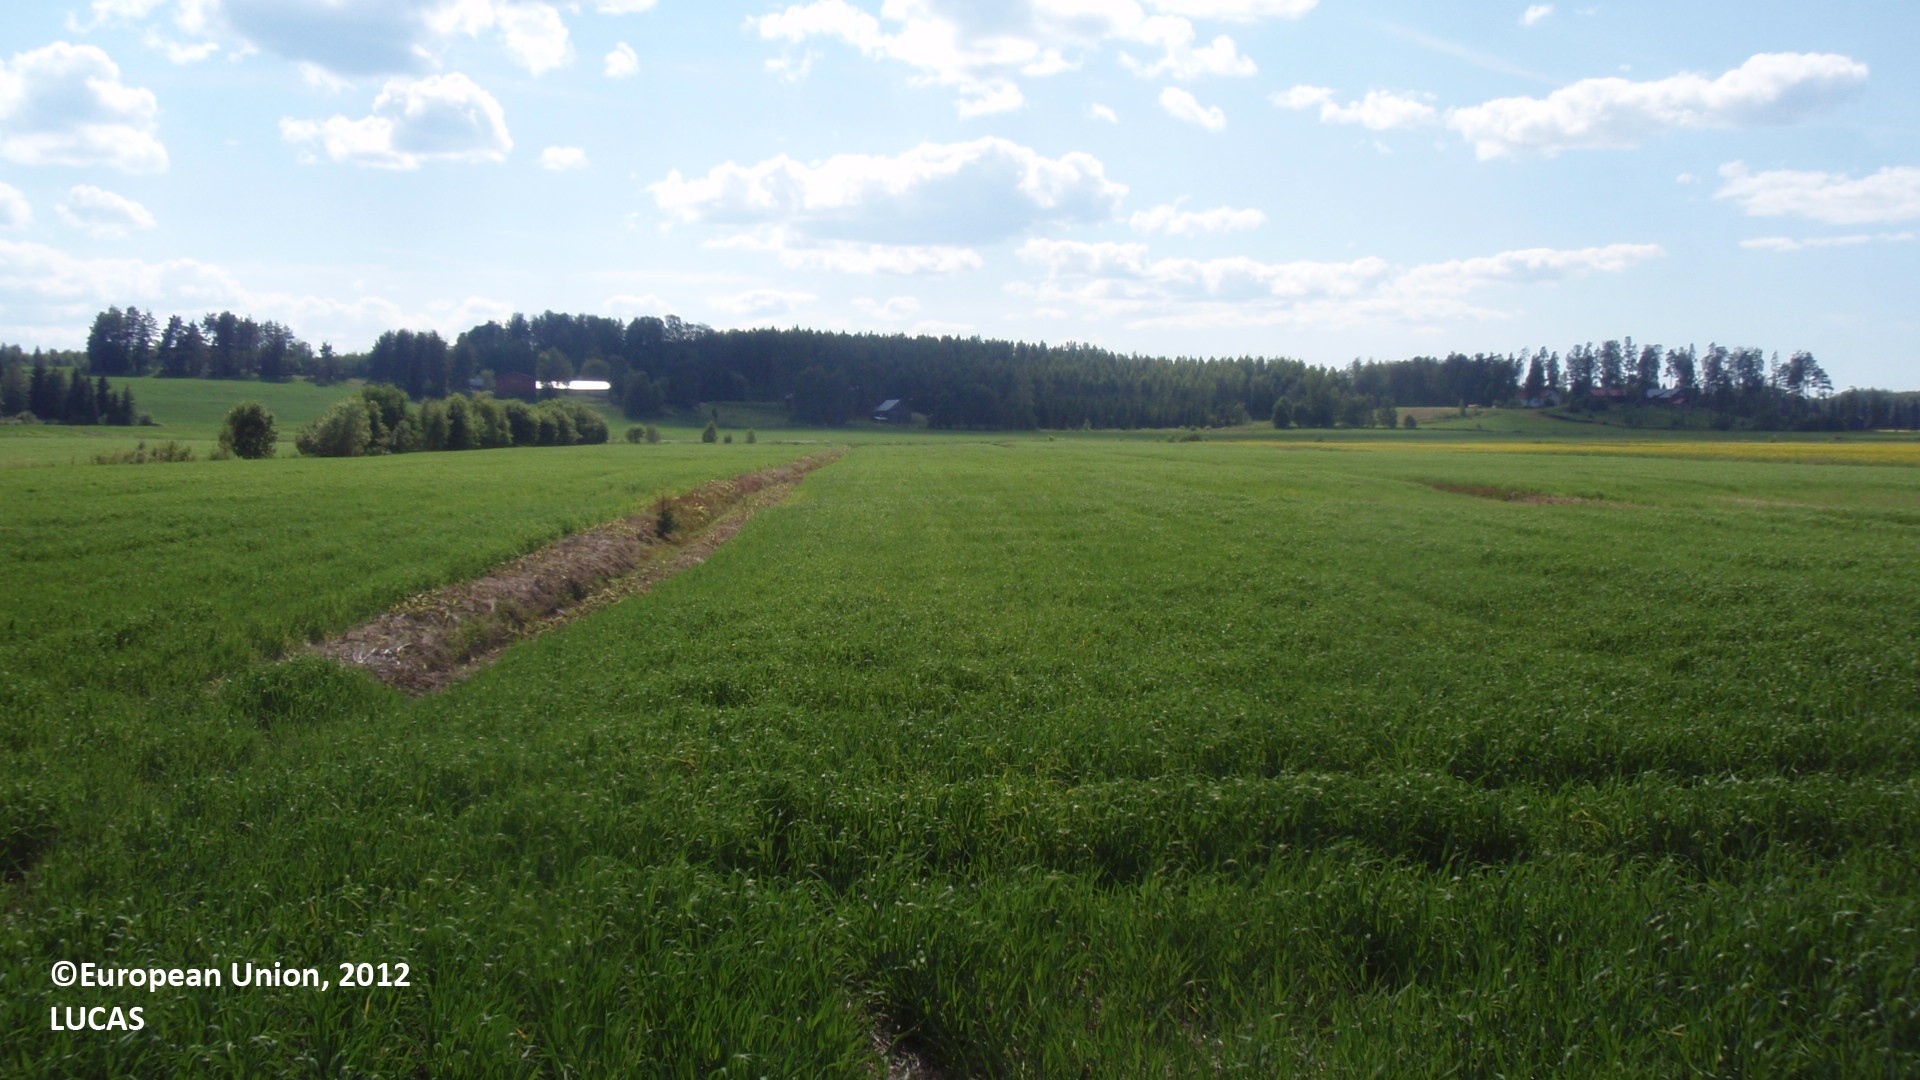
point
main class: Cropland
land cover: Barley
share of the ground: > 75 %
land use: Agriculture (excluding fallow land and kitchen gardens)
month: July
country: FI
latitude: 61.5208
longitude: 29.6381
